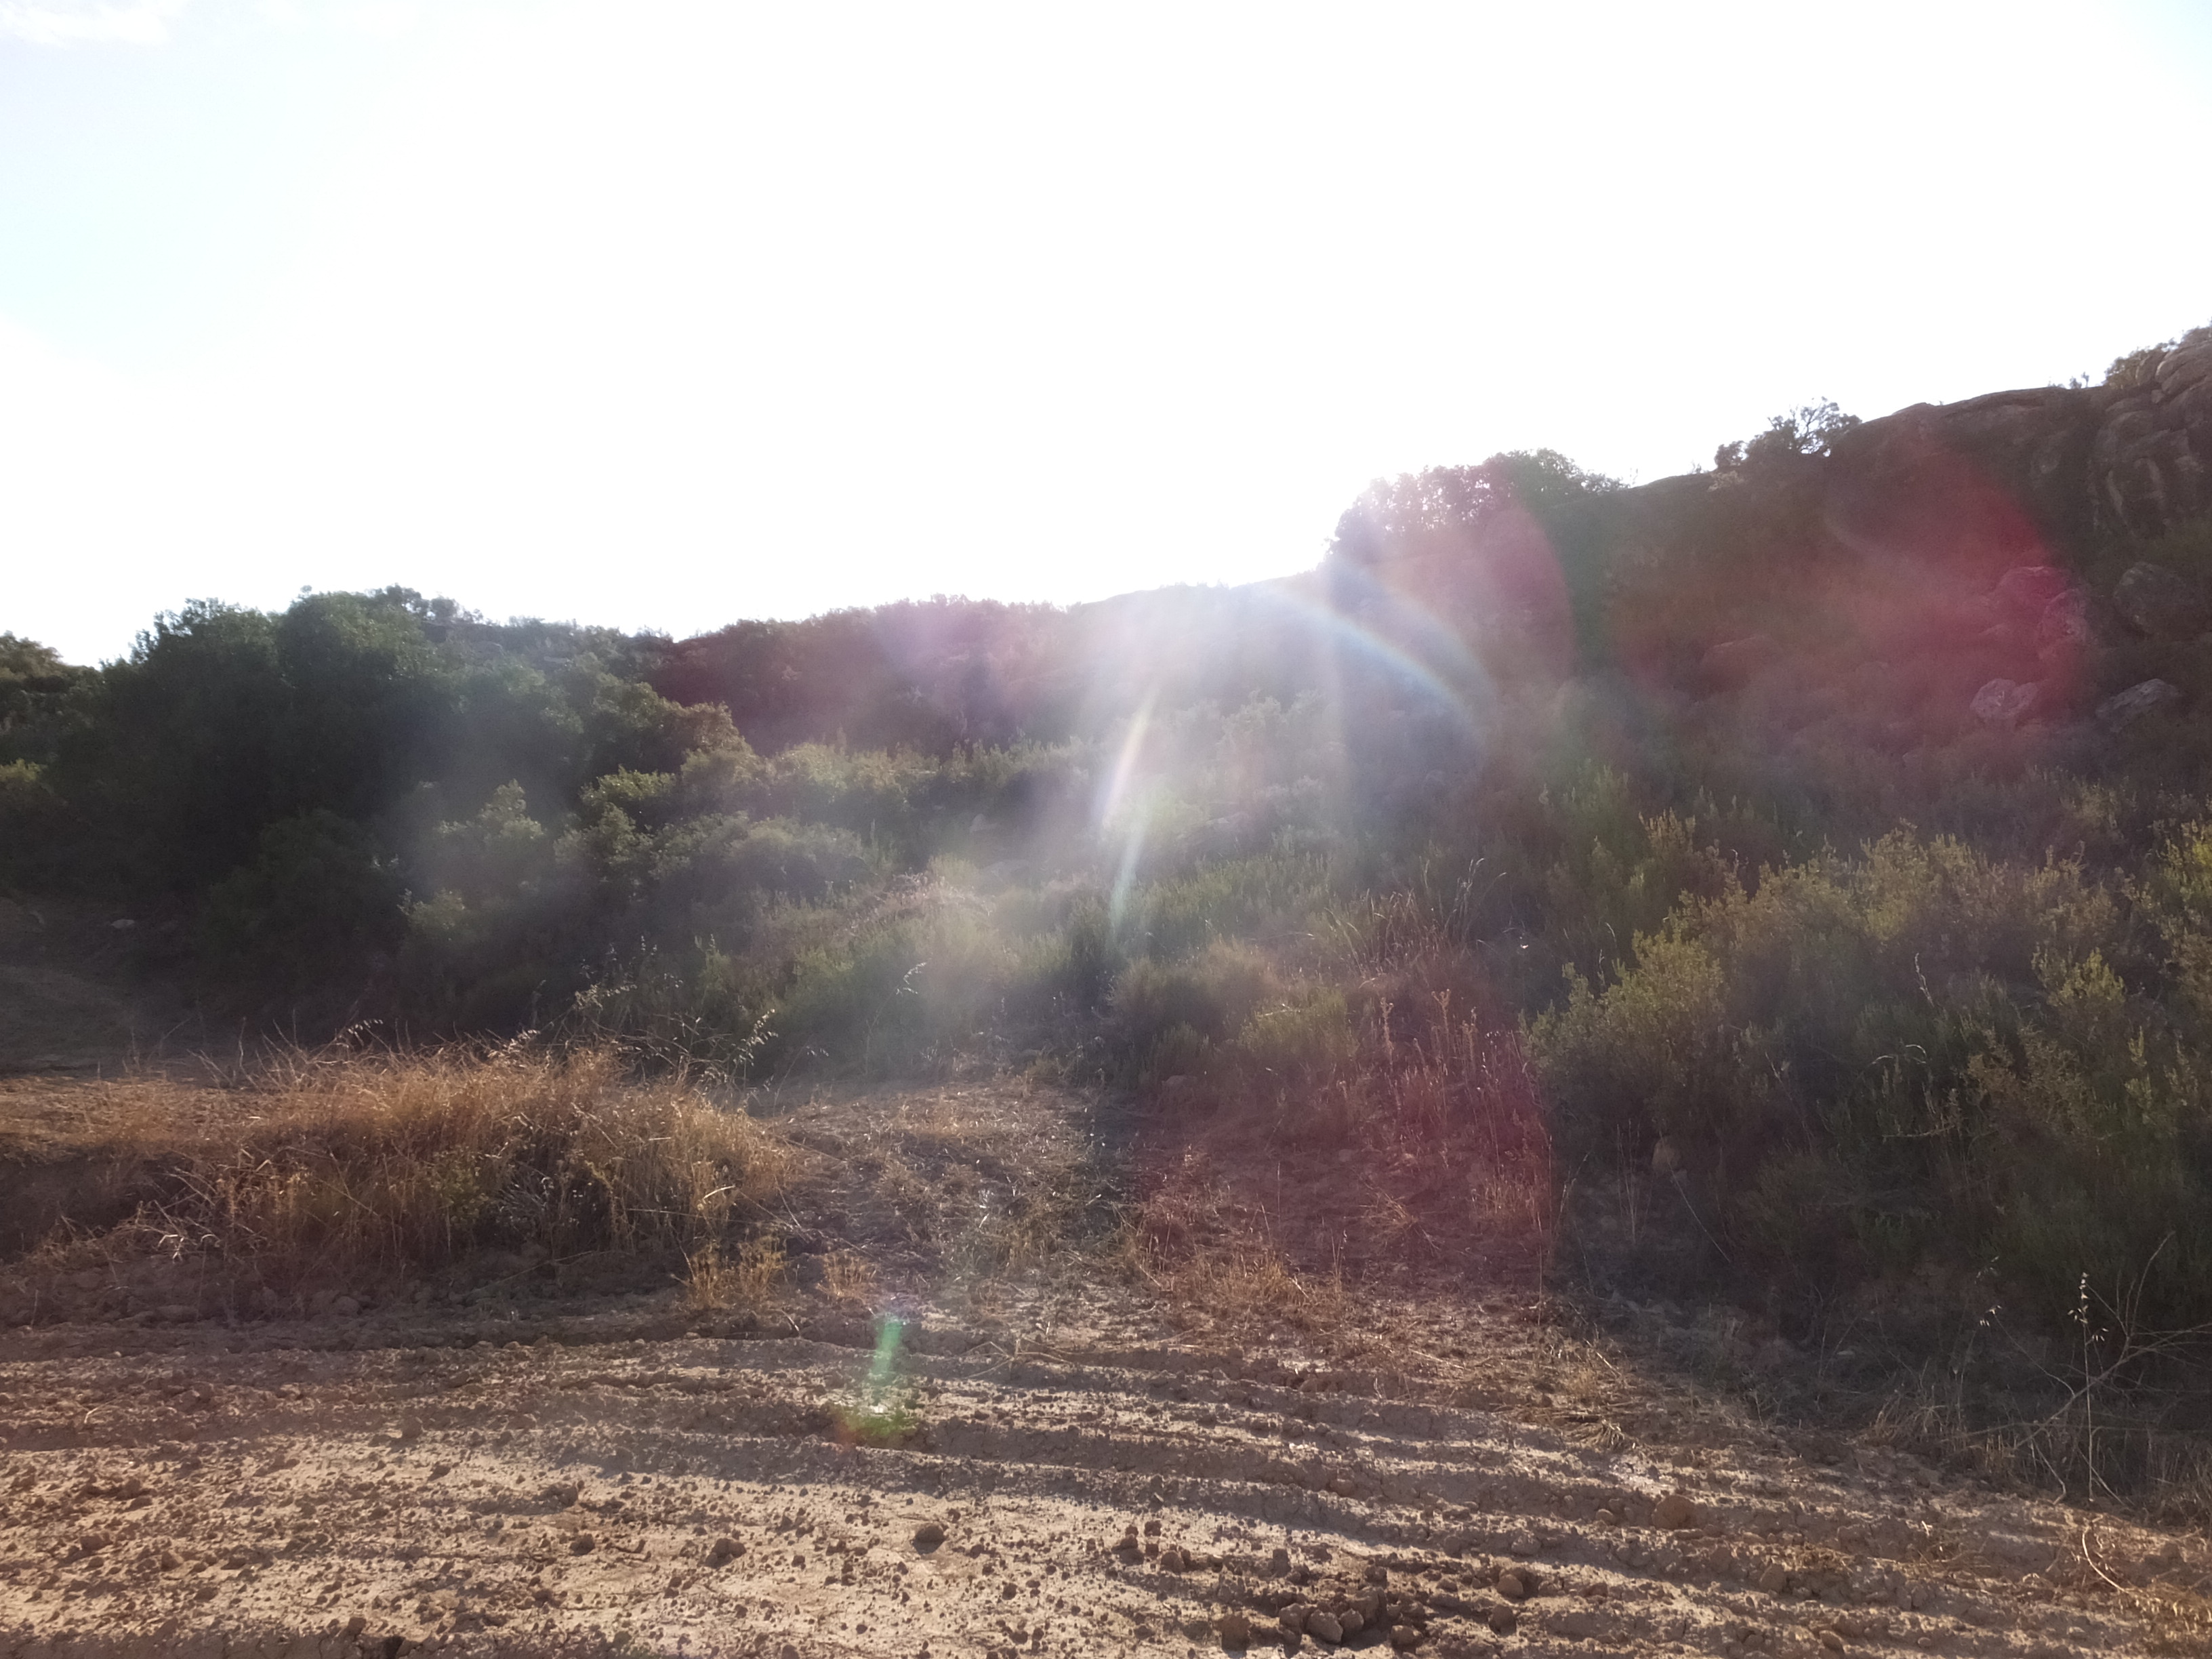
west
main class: Cropland
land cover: Olive groves
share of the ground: 50 - 75 %
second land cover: Other bare soil
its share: > 75 %
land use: Agriculture (excluding fallow land and kitchen gardens)
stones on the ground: < 10 %
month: July
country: ES
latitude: 41.0990
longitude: 0.1431
